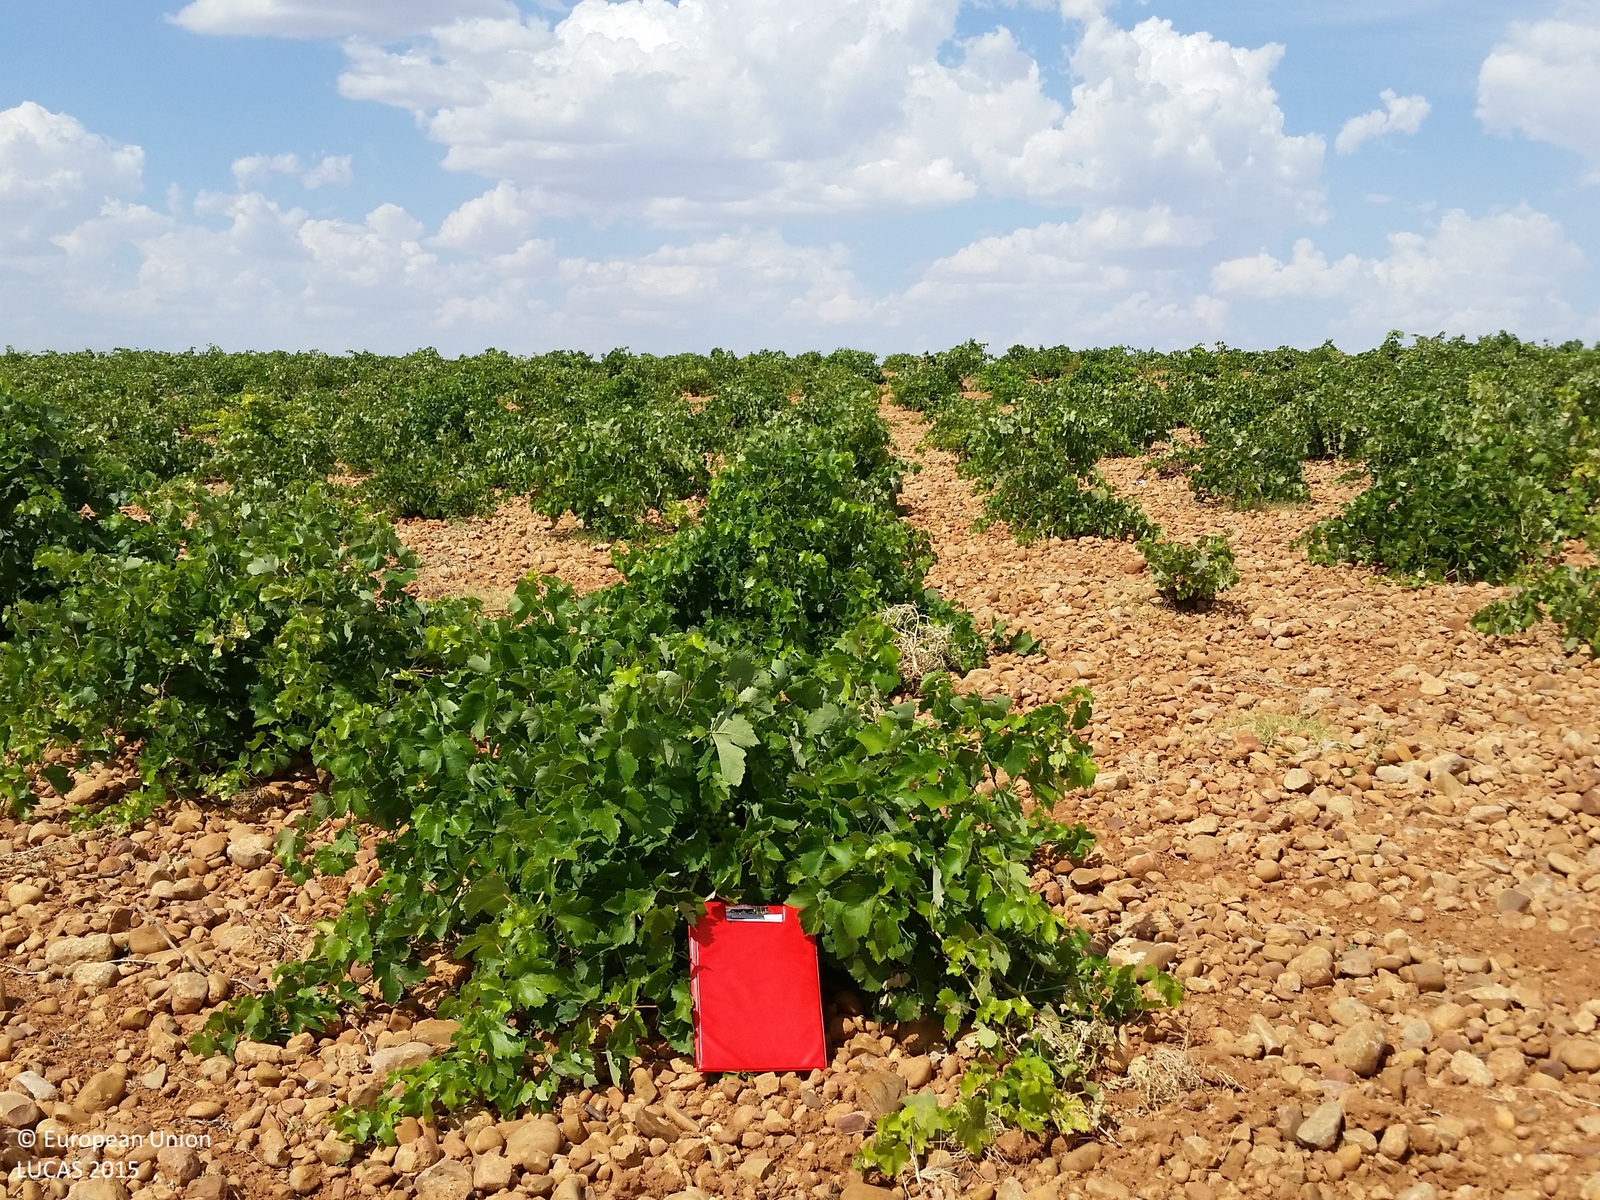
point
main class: Cropland
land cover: Vineyards
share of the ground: 50 - 75 %
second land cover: Other bare soil
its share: > 75 %
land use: Agriculture (excluding fallow land and kitchen gardens)
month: July
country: ES
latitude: 39.2049
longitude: -2.6670
